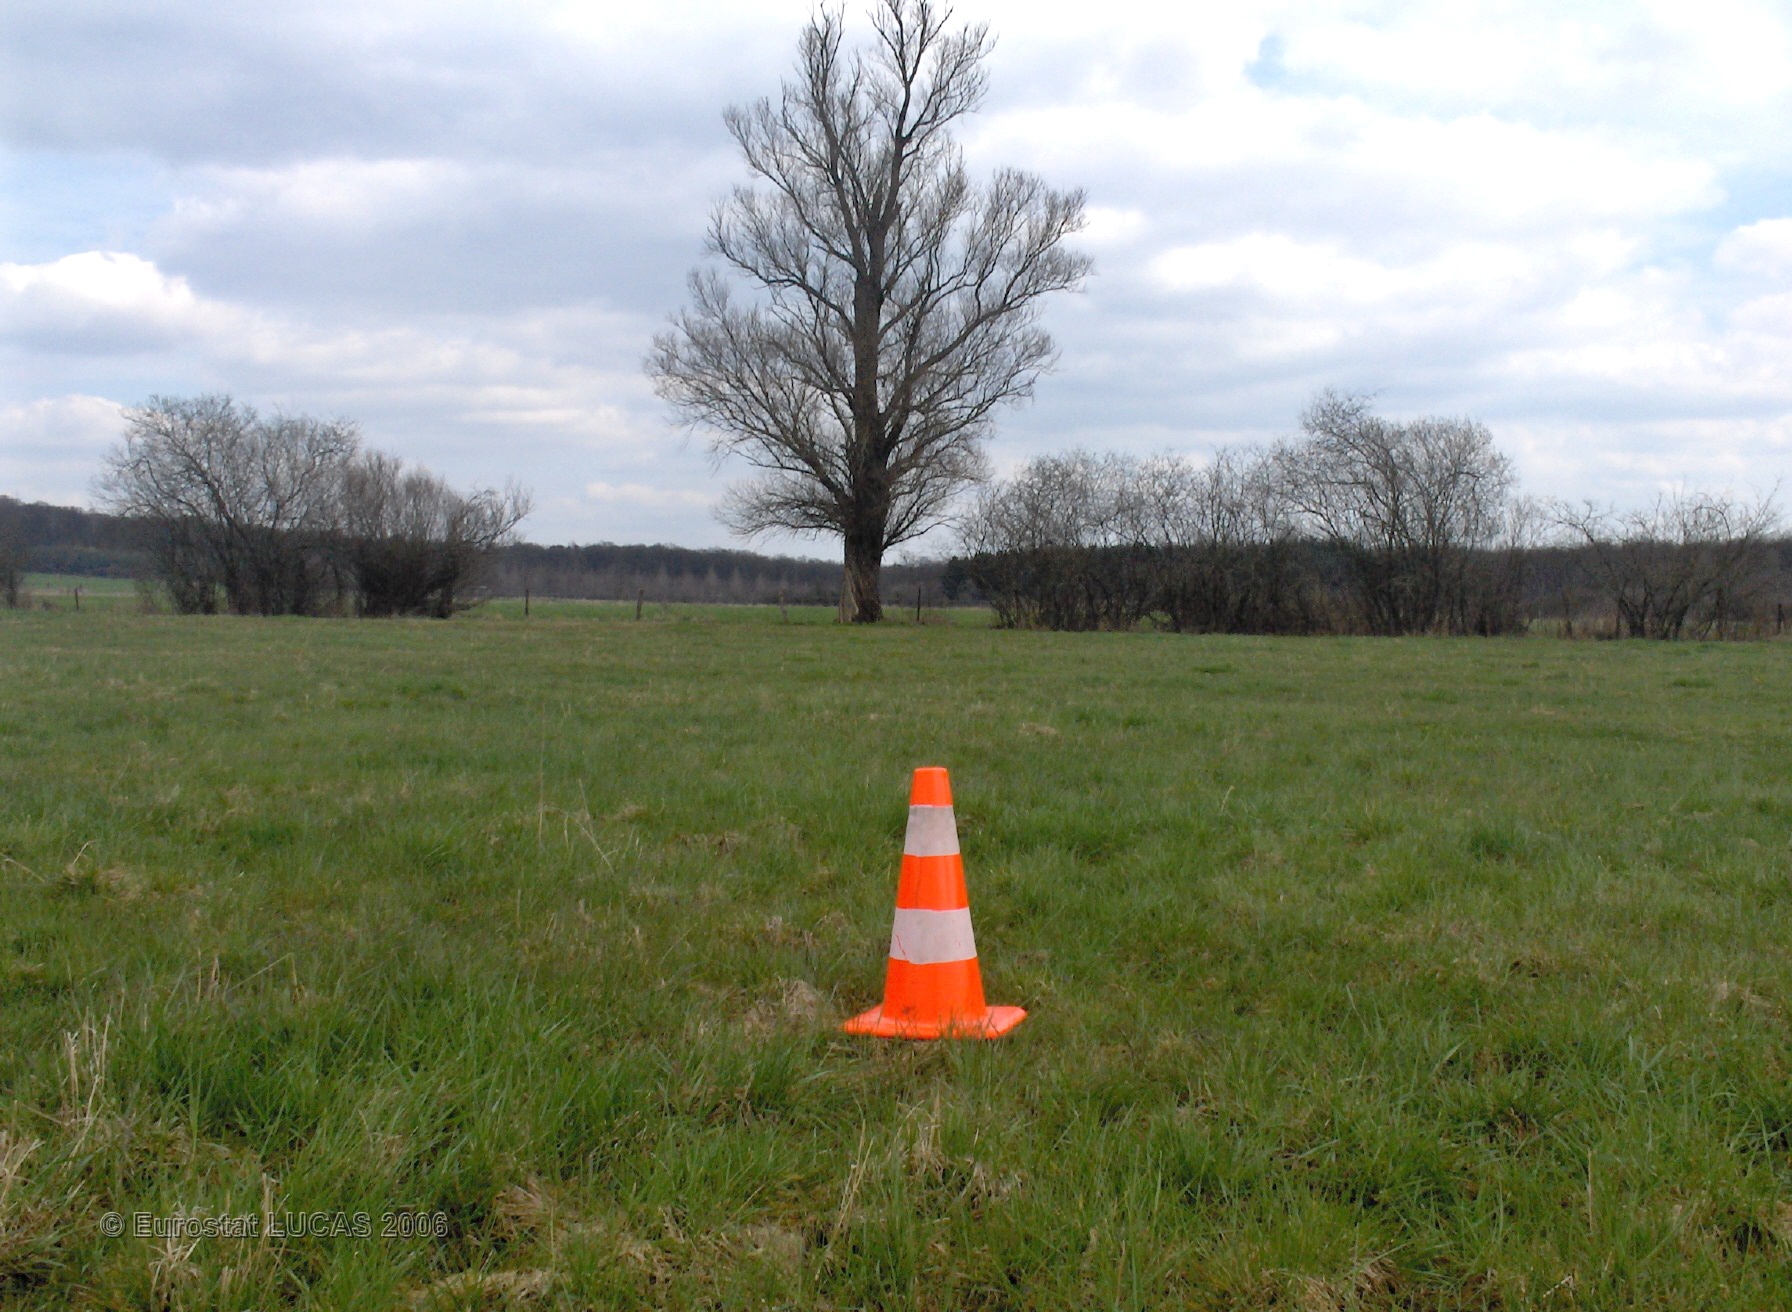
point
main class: Grassland
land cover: Grassland without tree/shrub cover
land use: Agriculture (excluding fallow land and kitchen gardens)
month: April
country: BE
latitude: 50.1263
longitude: 4.5548
